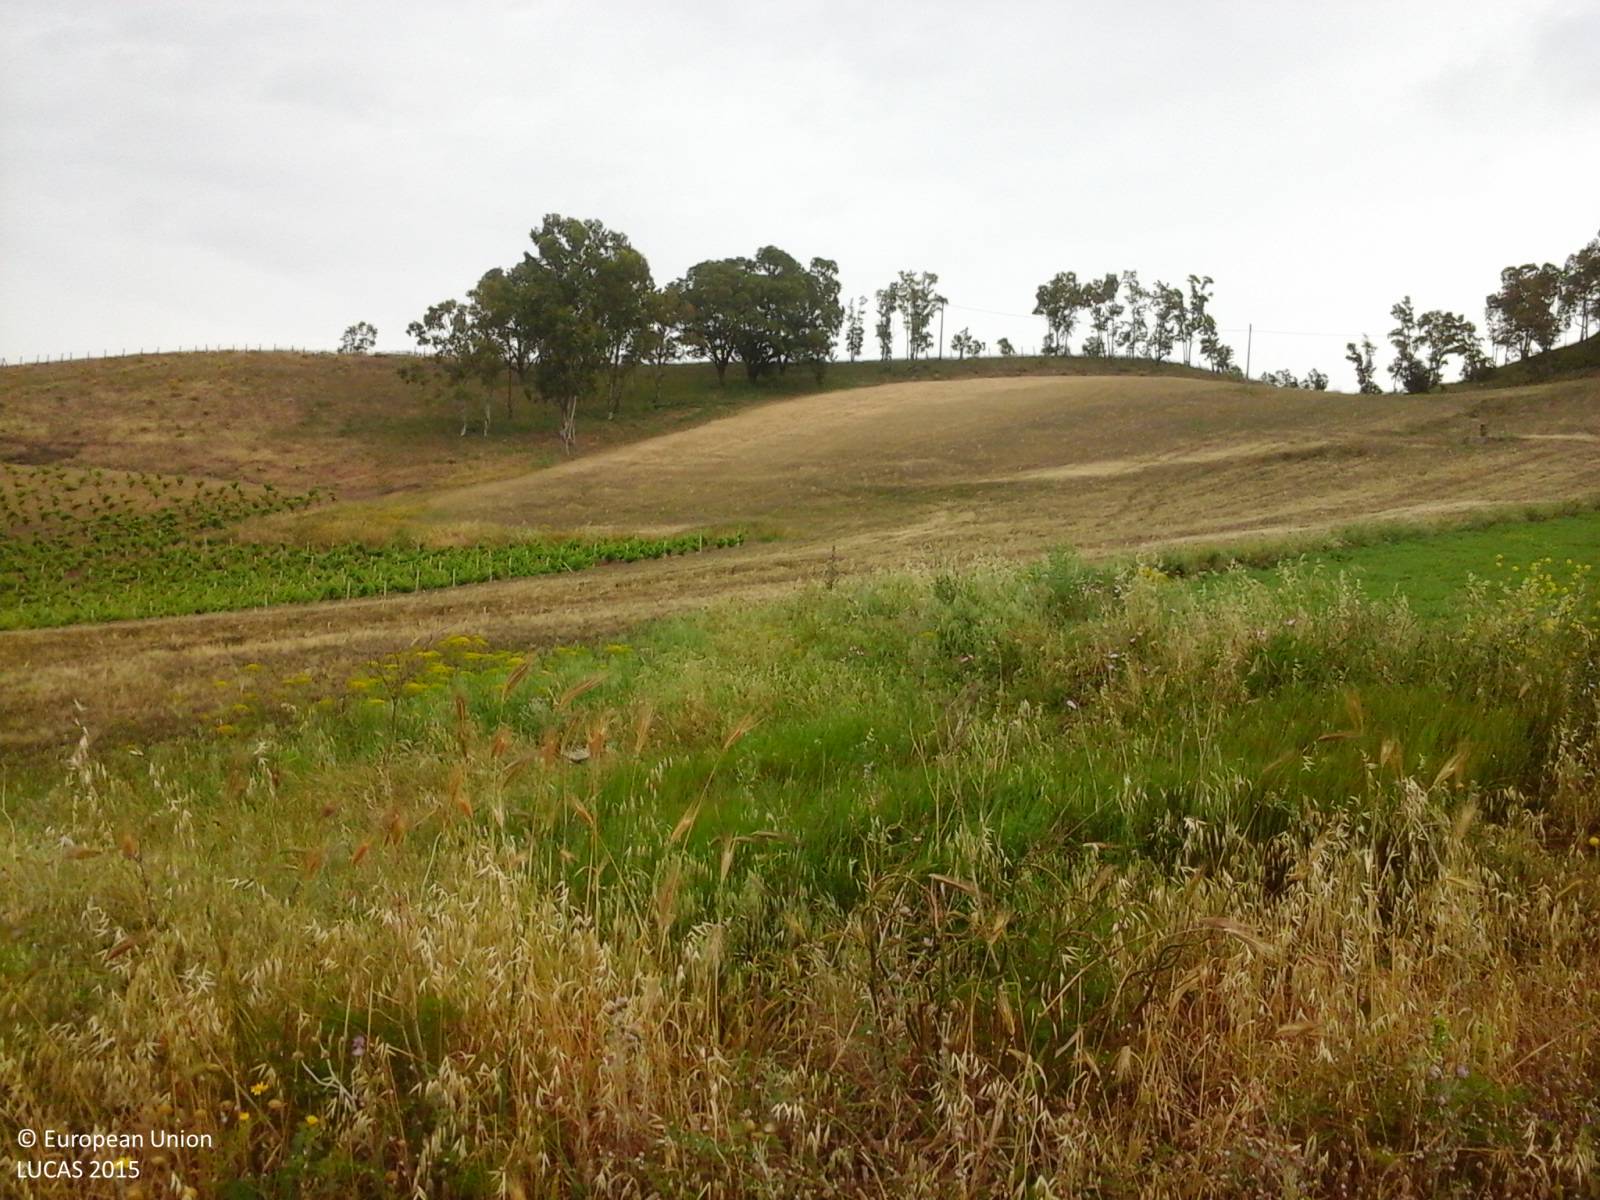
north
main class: Grassland
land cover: Grassland without tree/shrub cover
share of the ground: > 75 %
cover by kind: herbaceous plants 100 %
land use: Agriculture (excluding fallow land and kitchen gardens)
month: May
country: IT
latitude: 37.8952
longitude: 13.1499
